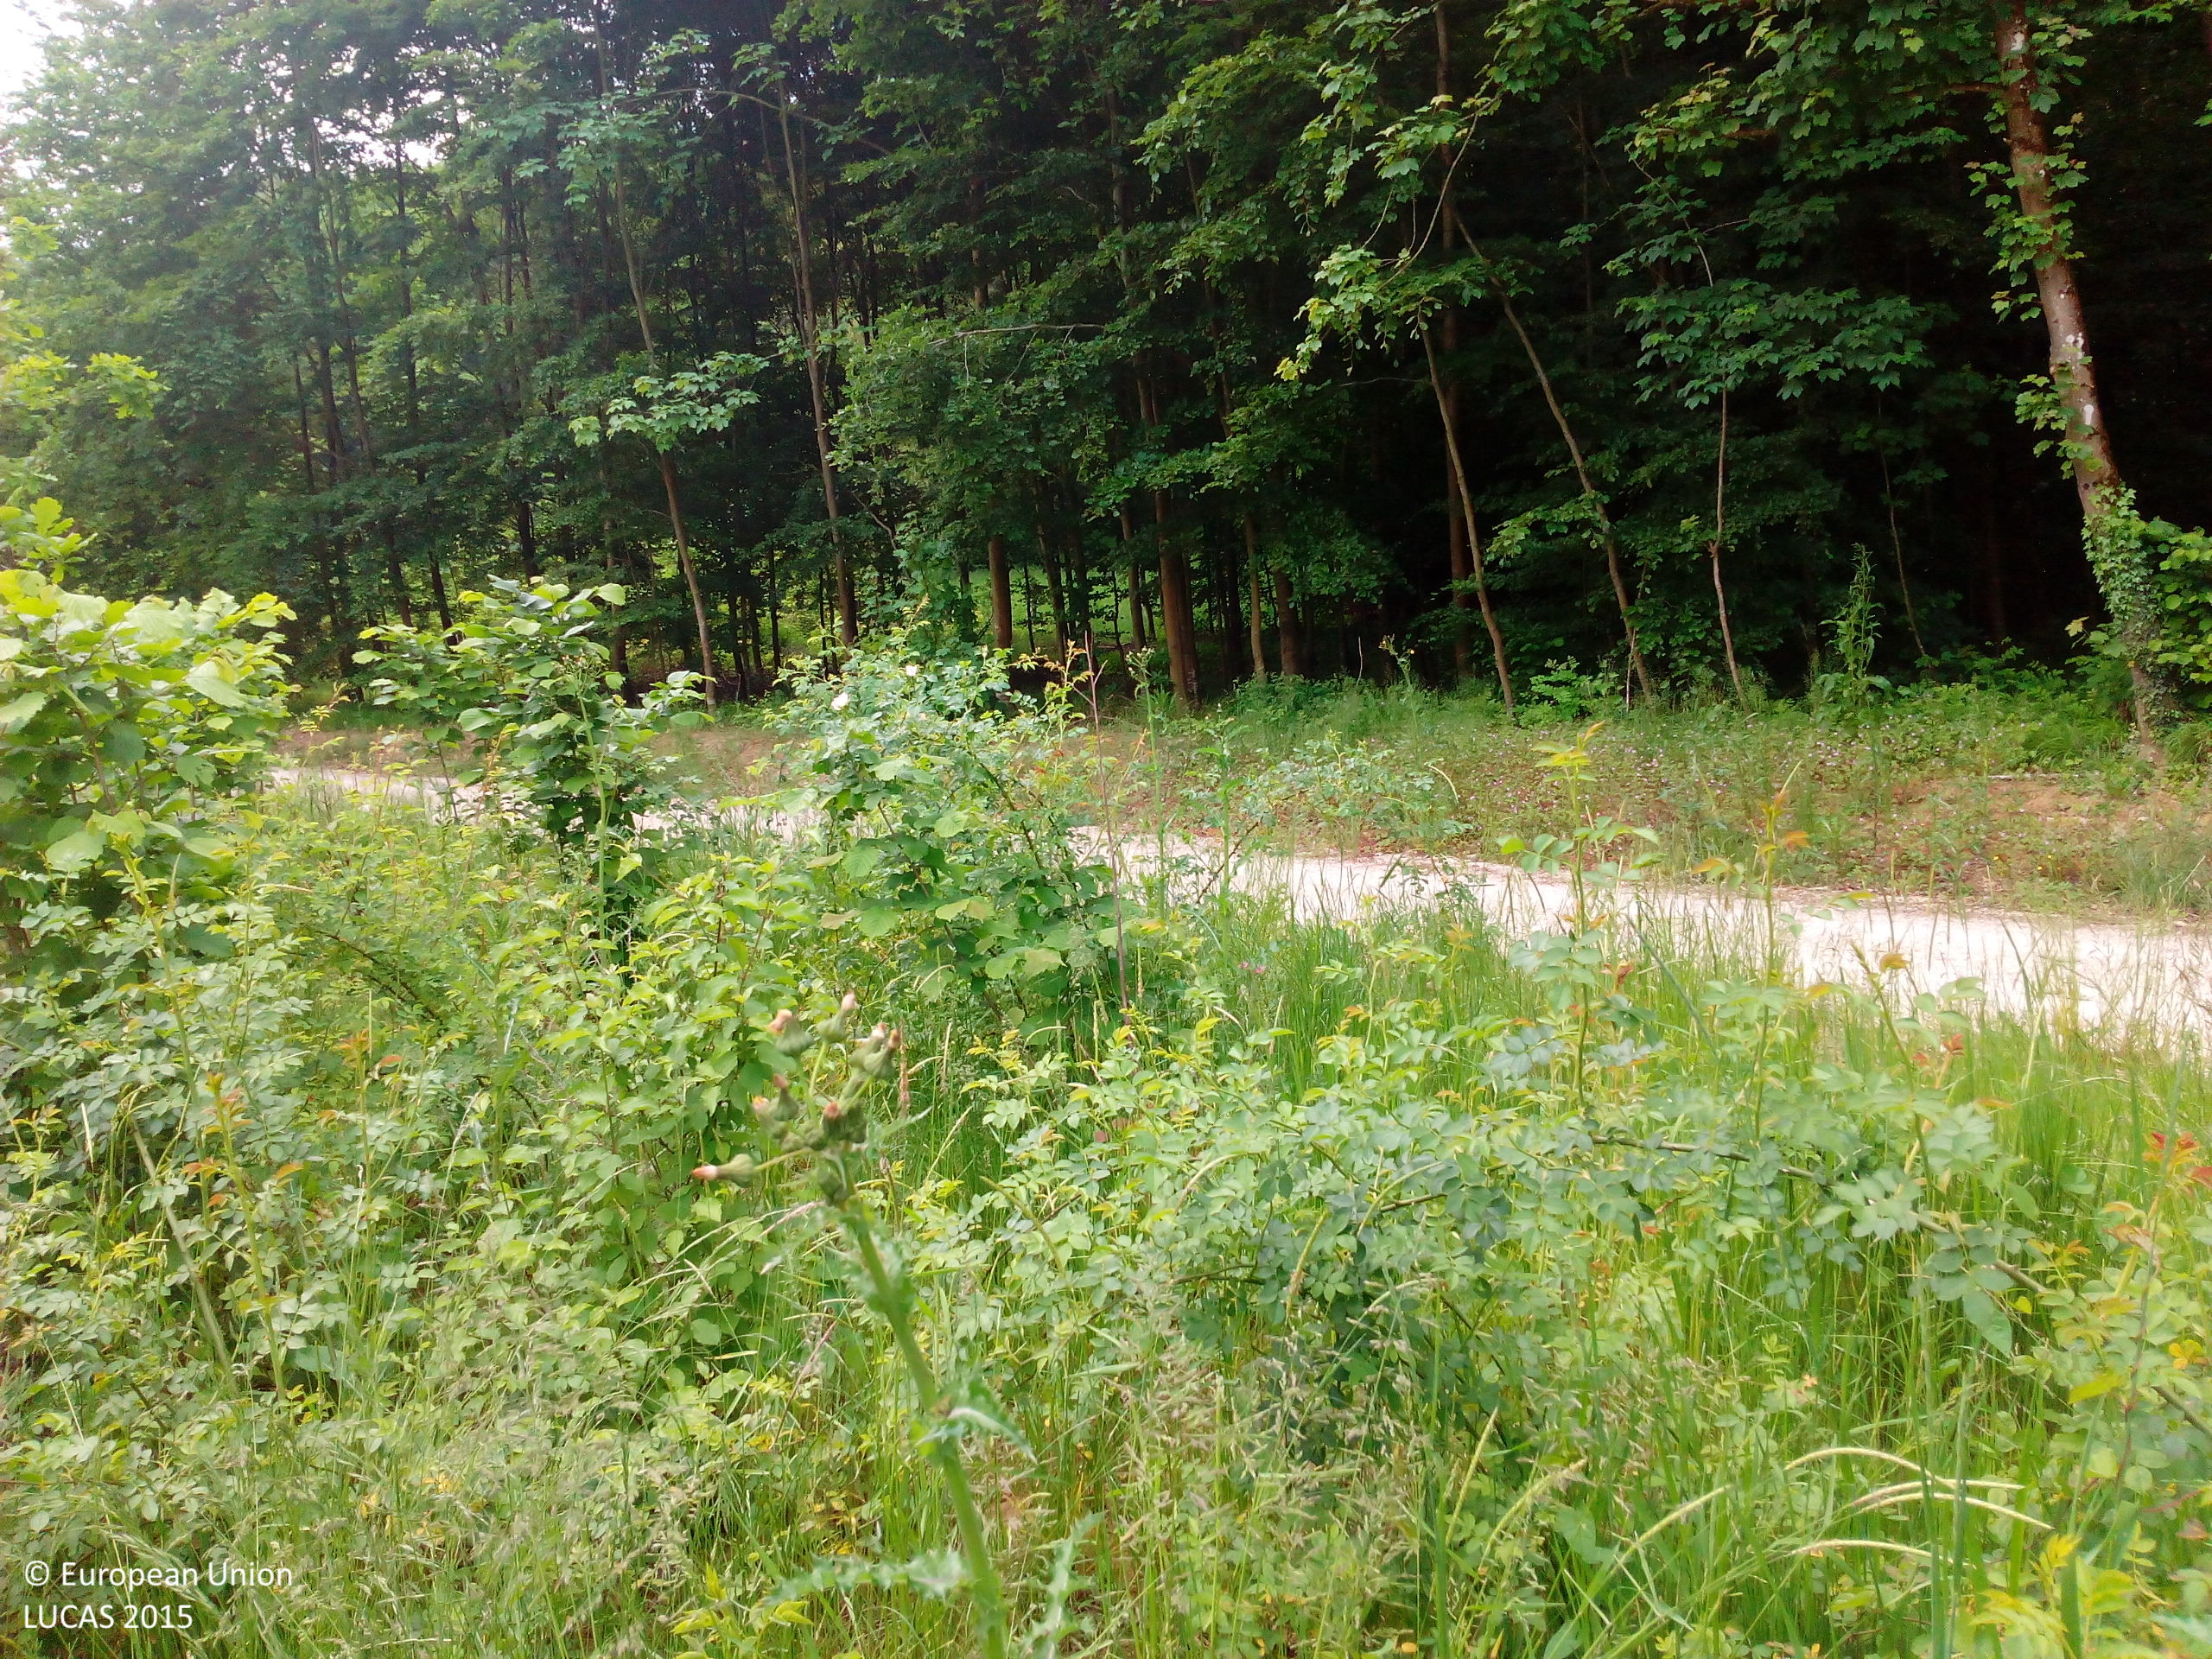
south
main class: Grassland
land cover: Grassland with sparse tree/shrub cover
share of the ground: > 75 %
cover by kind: herbaceous plants 90 %, broadleaved forest trees 5 %, shrubs 5 %
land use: Semi-natural and natural areas not in use
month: May
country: DE
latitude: 47.7470
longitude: 7.5873
